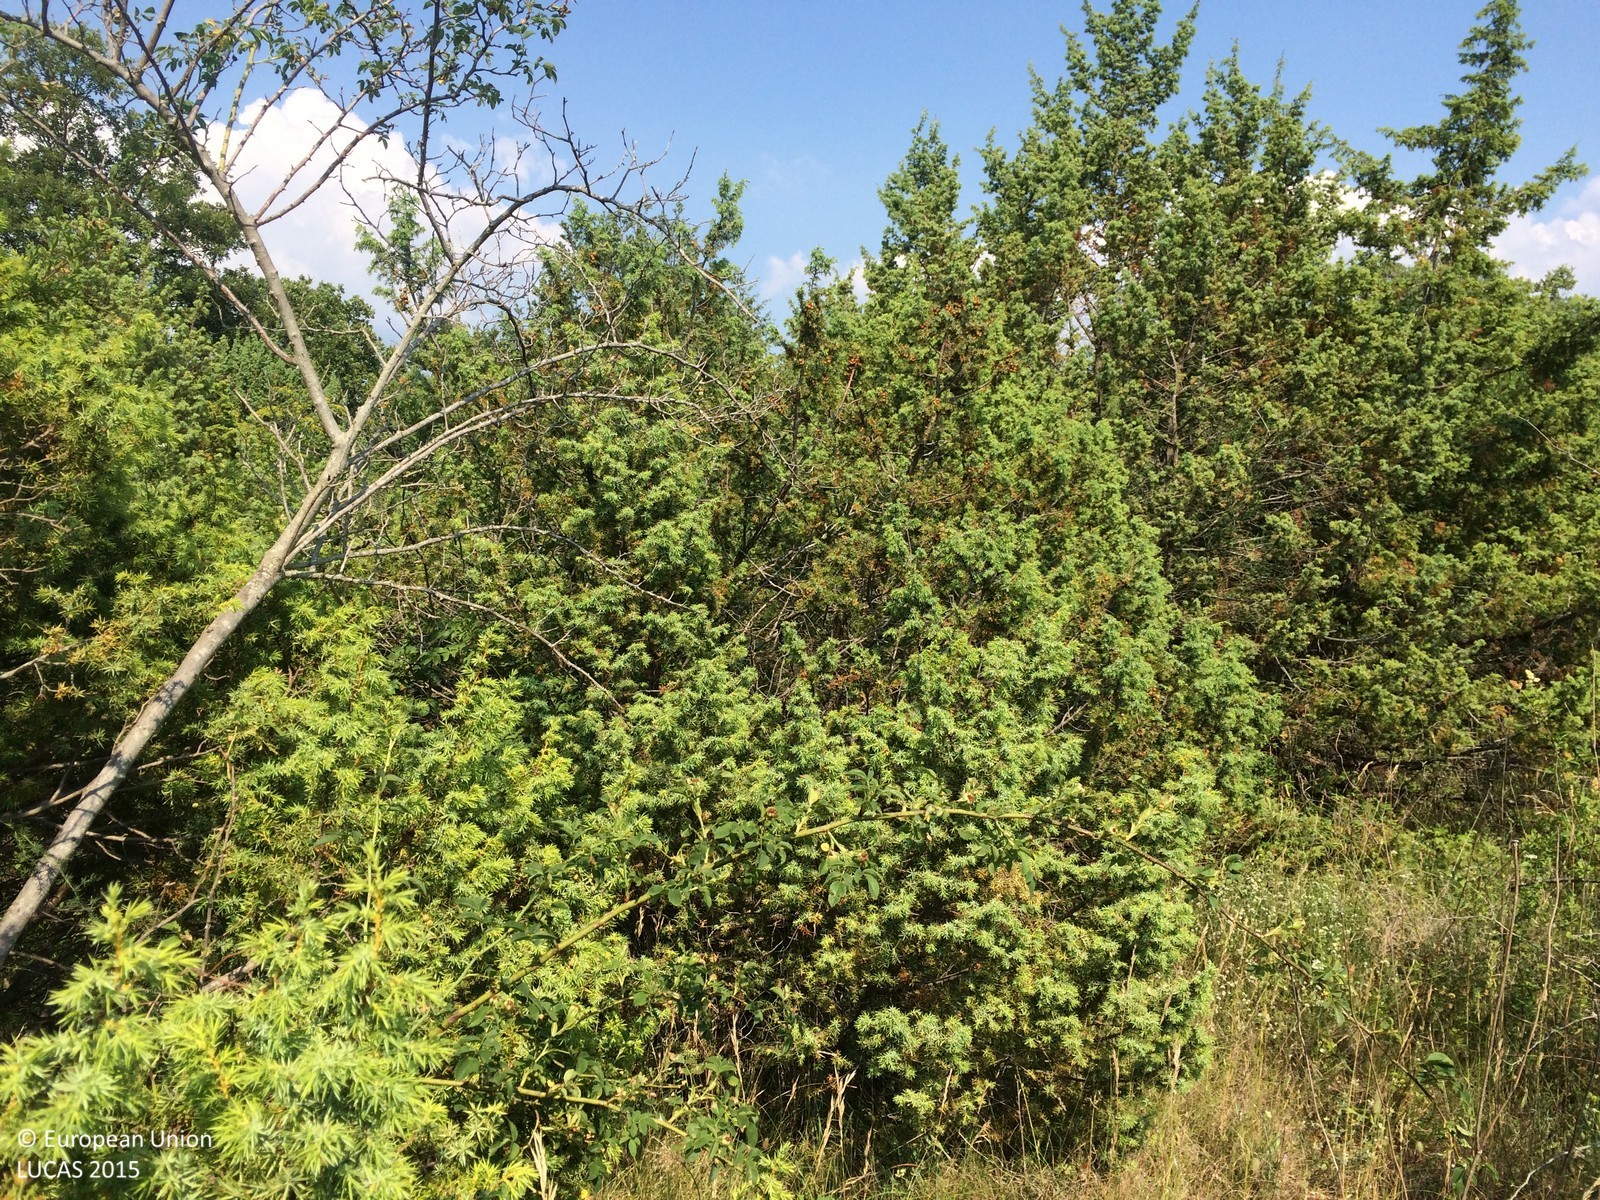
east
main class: Shrubland
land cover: Shrubland without tree cover
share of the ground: > 75 %
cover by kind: shrubs 90 %, herbaceous plants 10 %
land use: Semi-natural and natural areas not in use
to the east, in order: Shrubland without tree cover; Shrubland with sparse tree cover; Dry stone walls; Shrubland with sparse tree cover; Broadleaved woodland; Dry stone walls; Broadleaved woodland; Grassland with sparse tree/shrub cover; Dry stone walls; Broadleaved woodland; Dry stone walls; Broadleaved woodland; Grassland with sparse tree/shrub cover; Broadleaved woodland
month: June
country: HR
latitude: 45.0736
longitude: 13.8432
